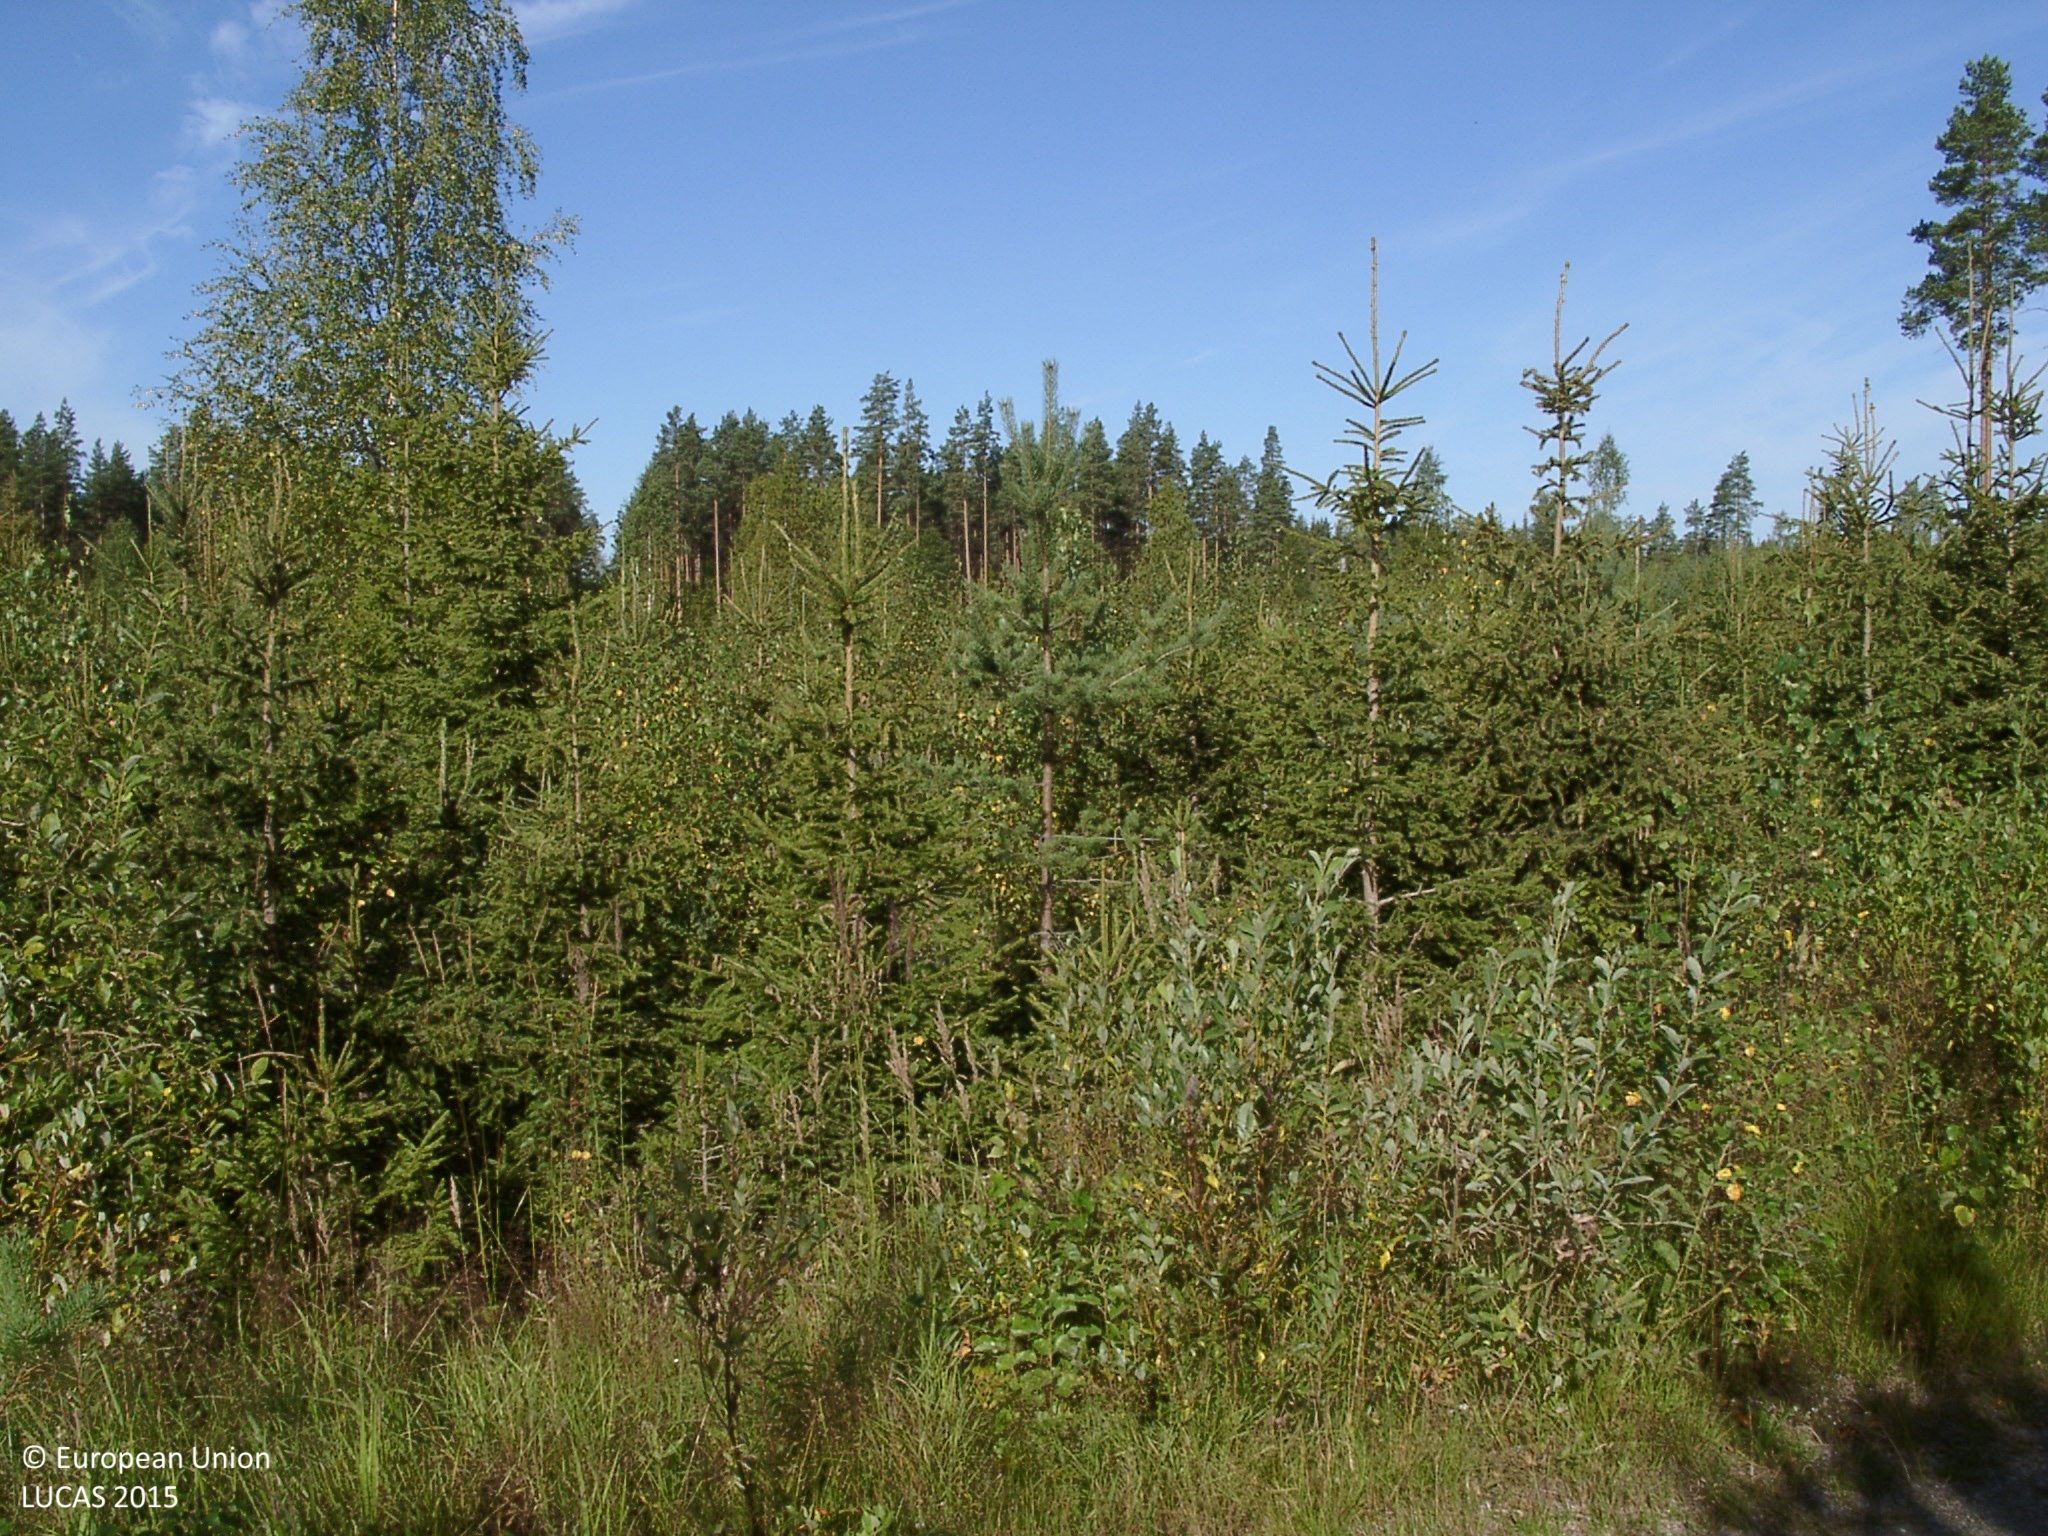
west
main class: Woodland
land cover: Other coniferous woodland
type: boreal forest
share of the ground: 50 - 75 %
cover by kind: coniferous forest trees 65 %, shrubs 10 %, herbaceous plants 5 %, lichens and mosses 5 %
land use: Forestry
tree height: < 5 m
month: August
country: FI
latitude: 61.8949
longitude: 24.9663
